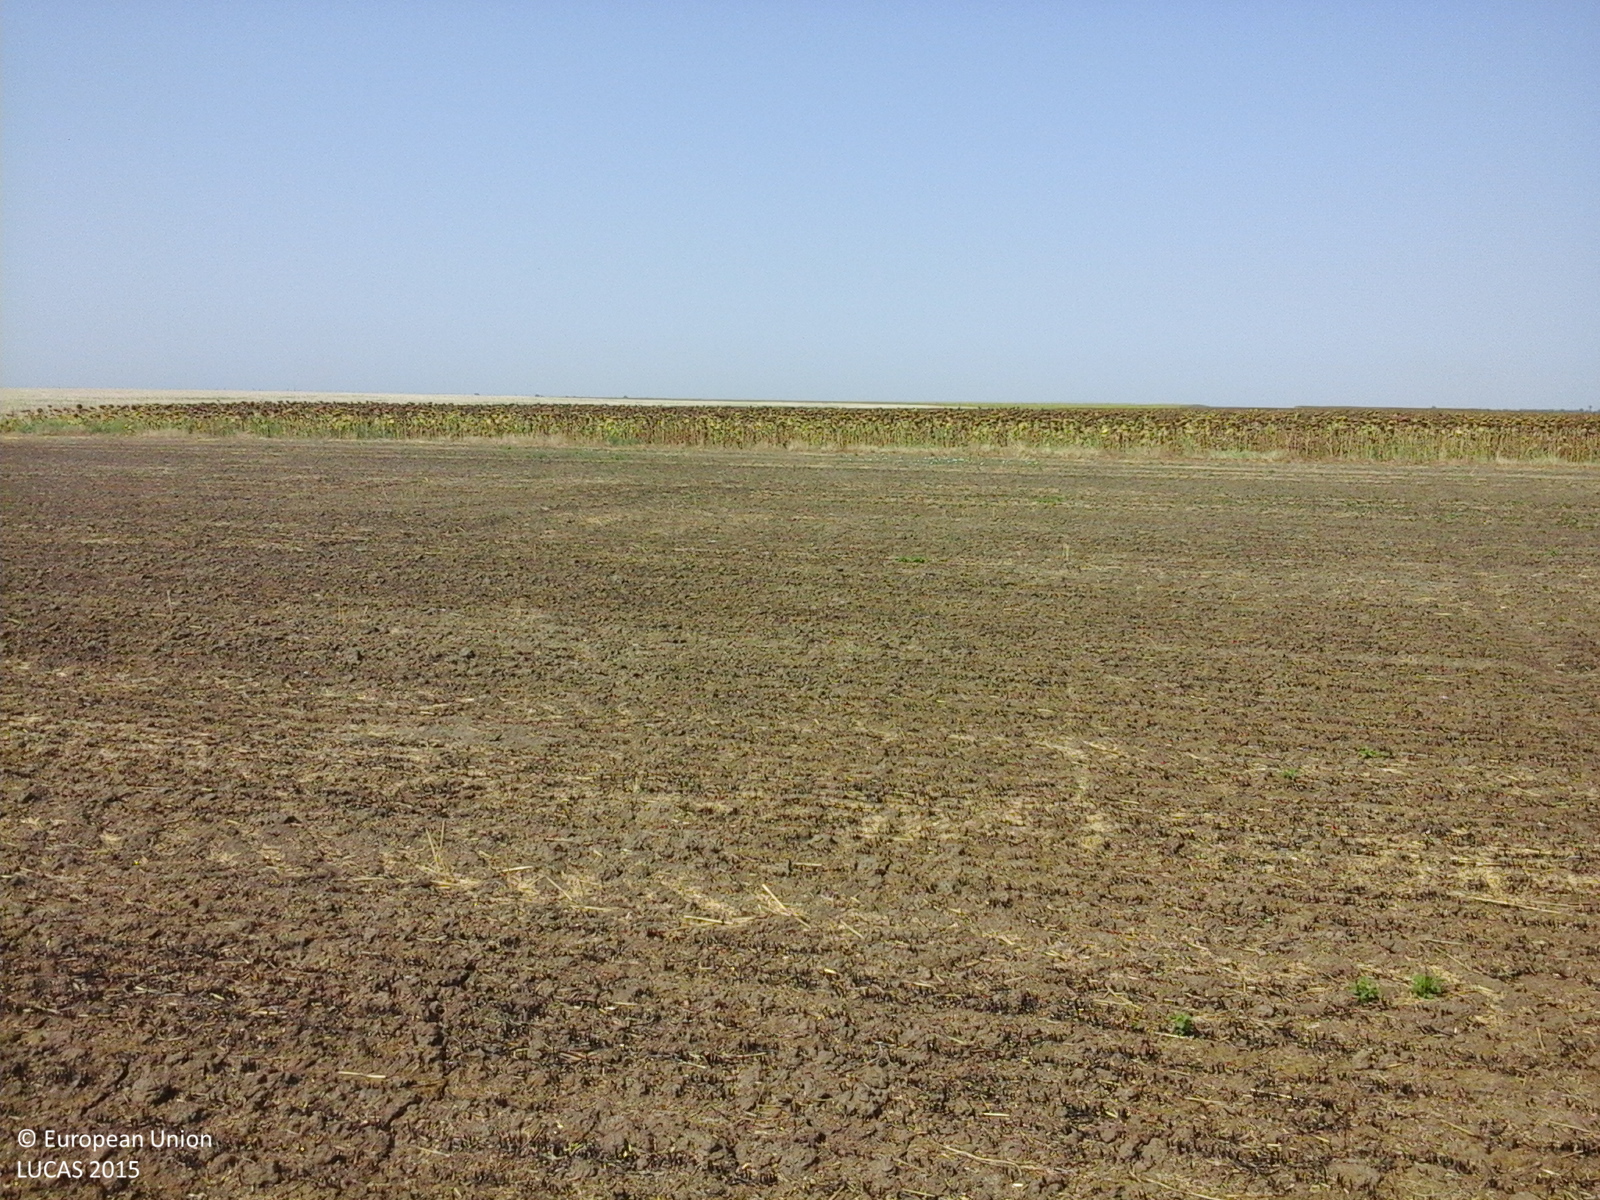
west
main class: Cropland
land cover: Durum wheat
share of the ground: 10 - 25 %
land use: Agriculture (excluding fallow land and kitchen gardens)
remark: Burnt area
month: August
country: RO
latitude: 44.1378
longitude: 23.2334
